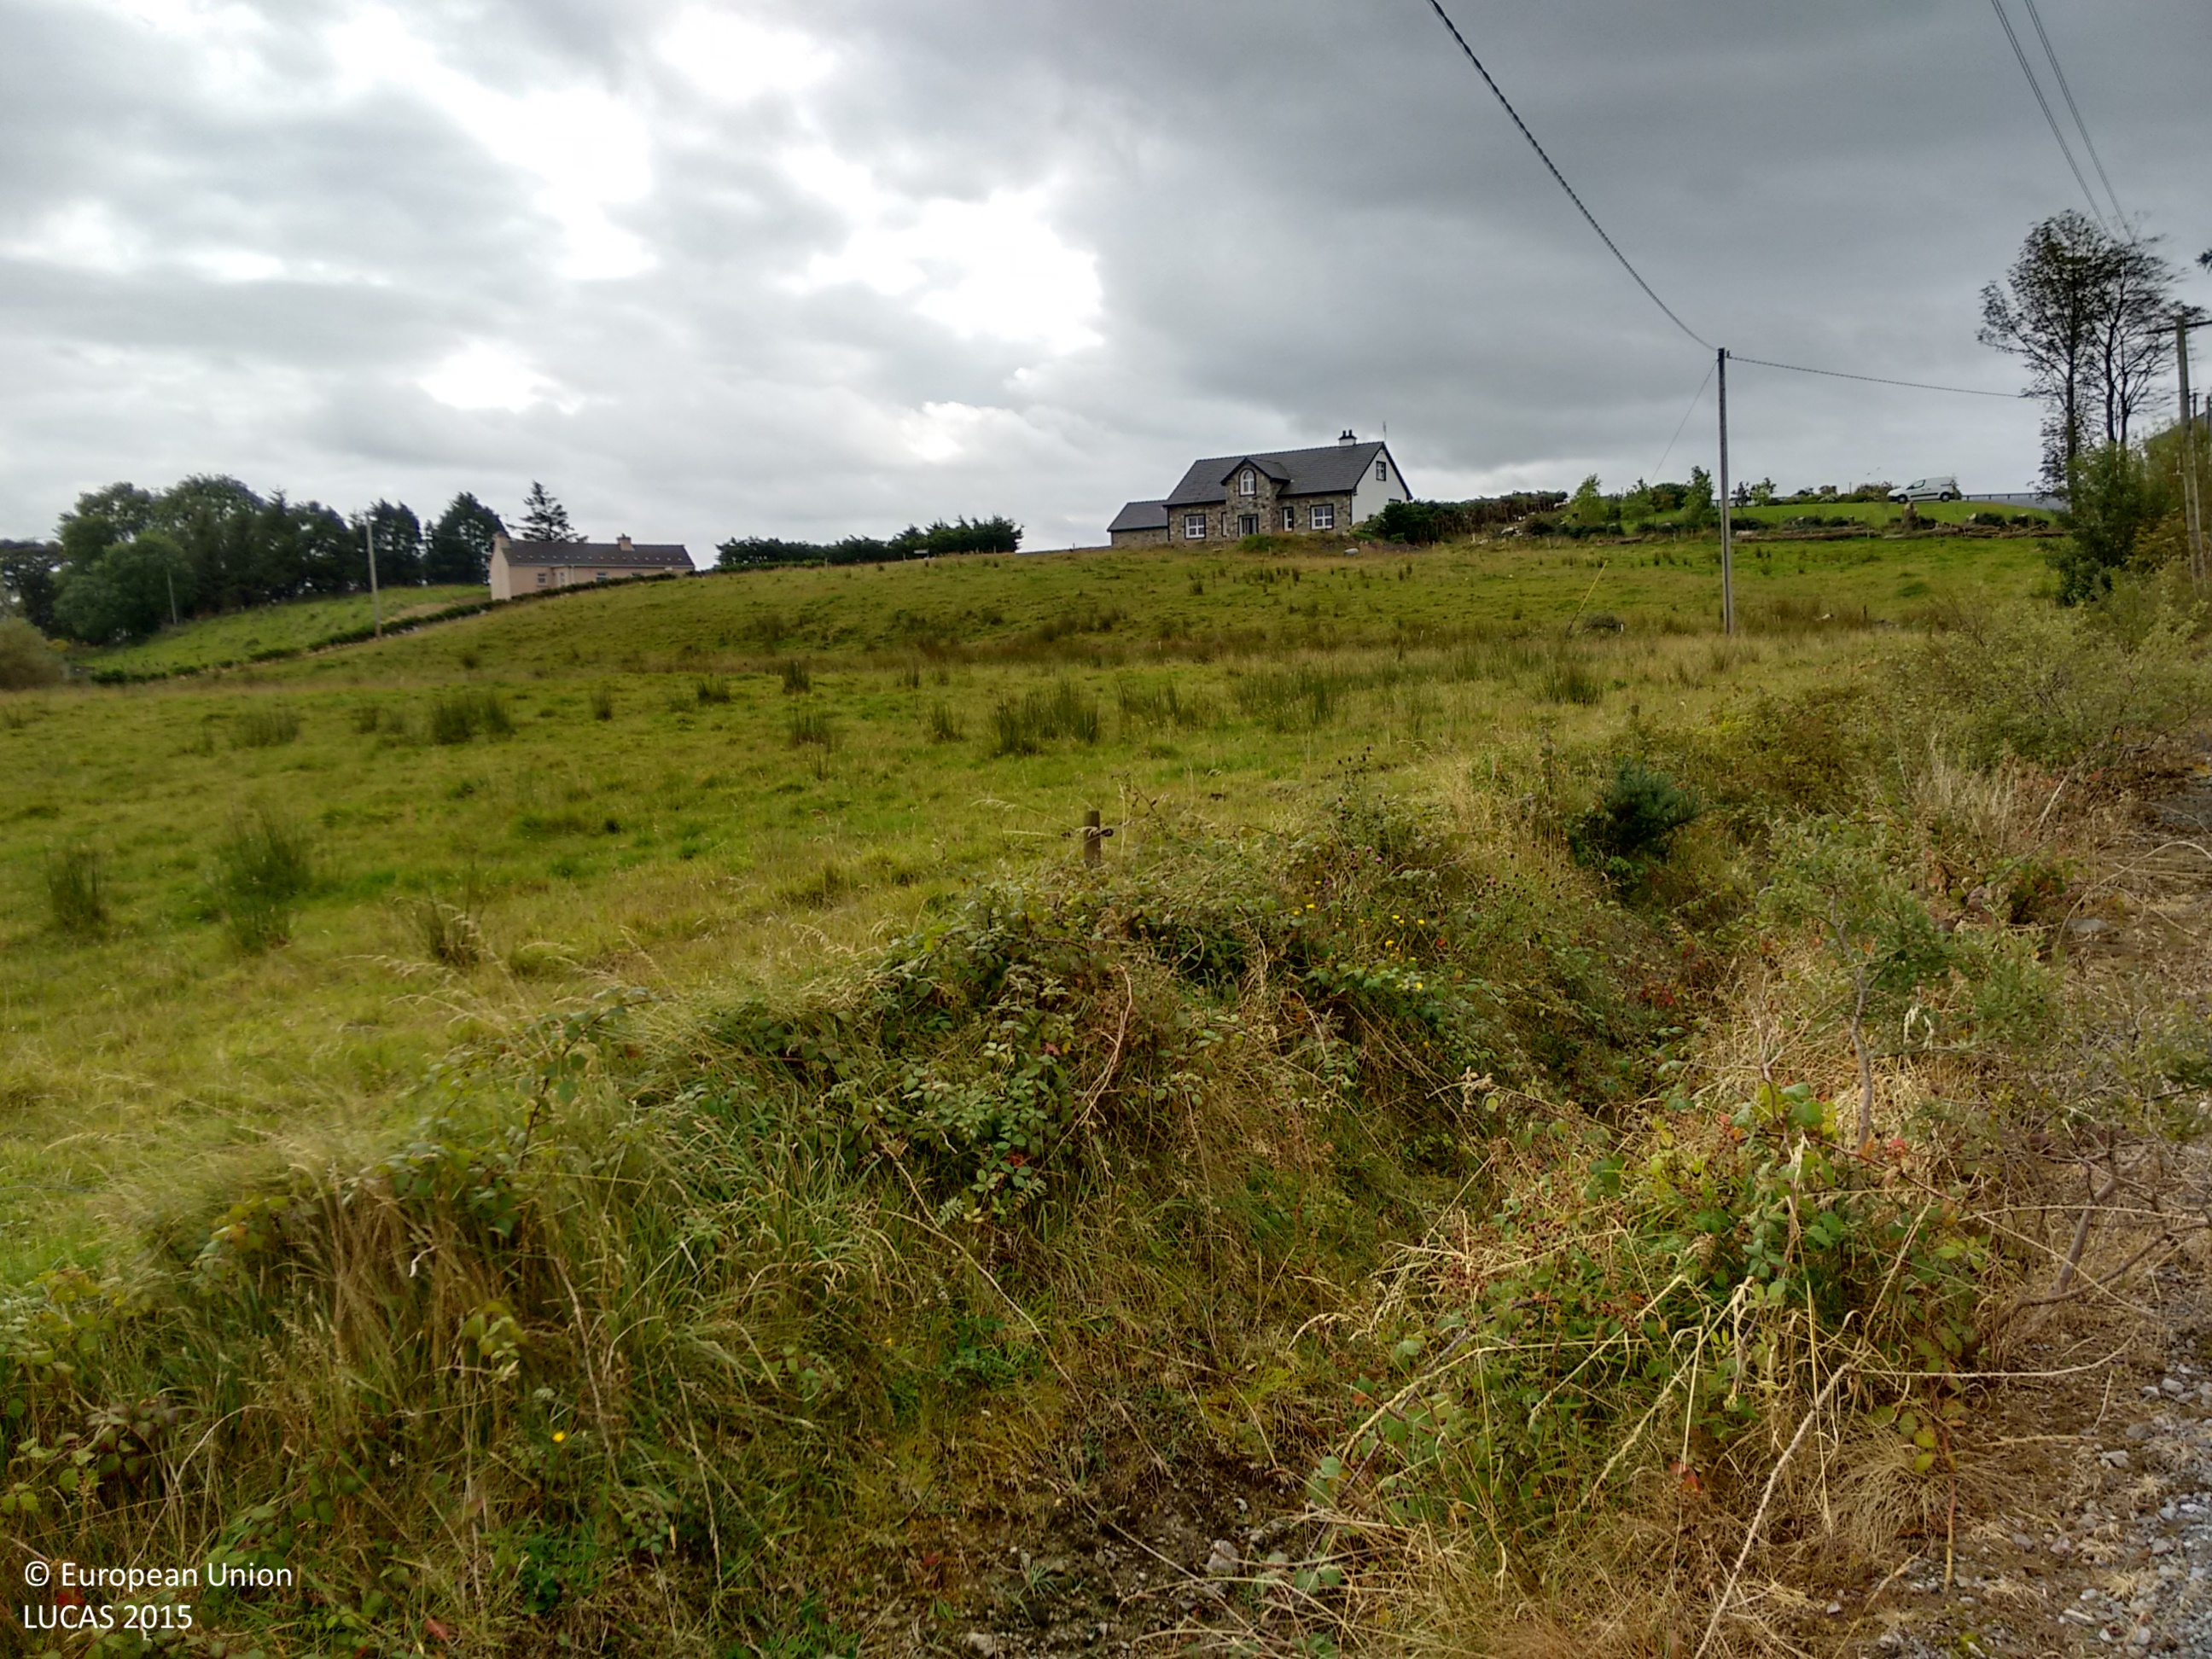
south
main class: Grassland
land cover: Grassland without tree/shrub cover
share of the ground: > 75 %
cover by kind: herbaceous plants 100 %
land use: Agriculture (excluding fallow land and kitchen gardens)
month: September
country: IE
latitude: 53.8386
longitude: -8.8843
